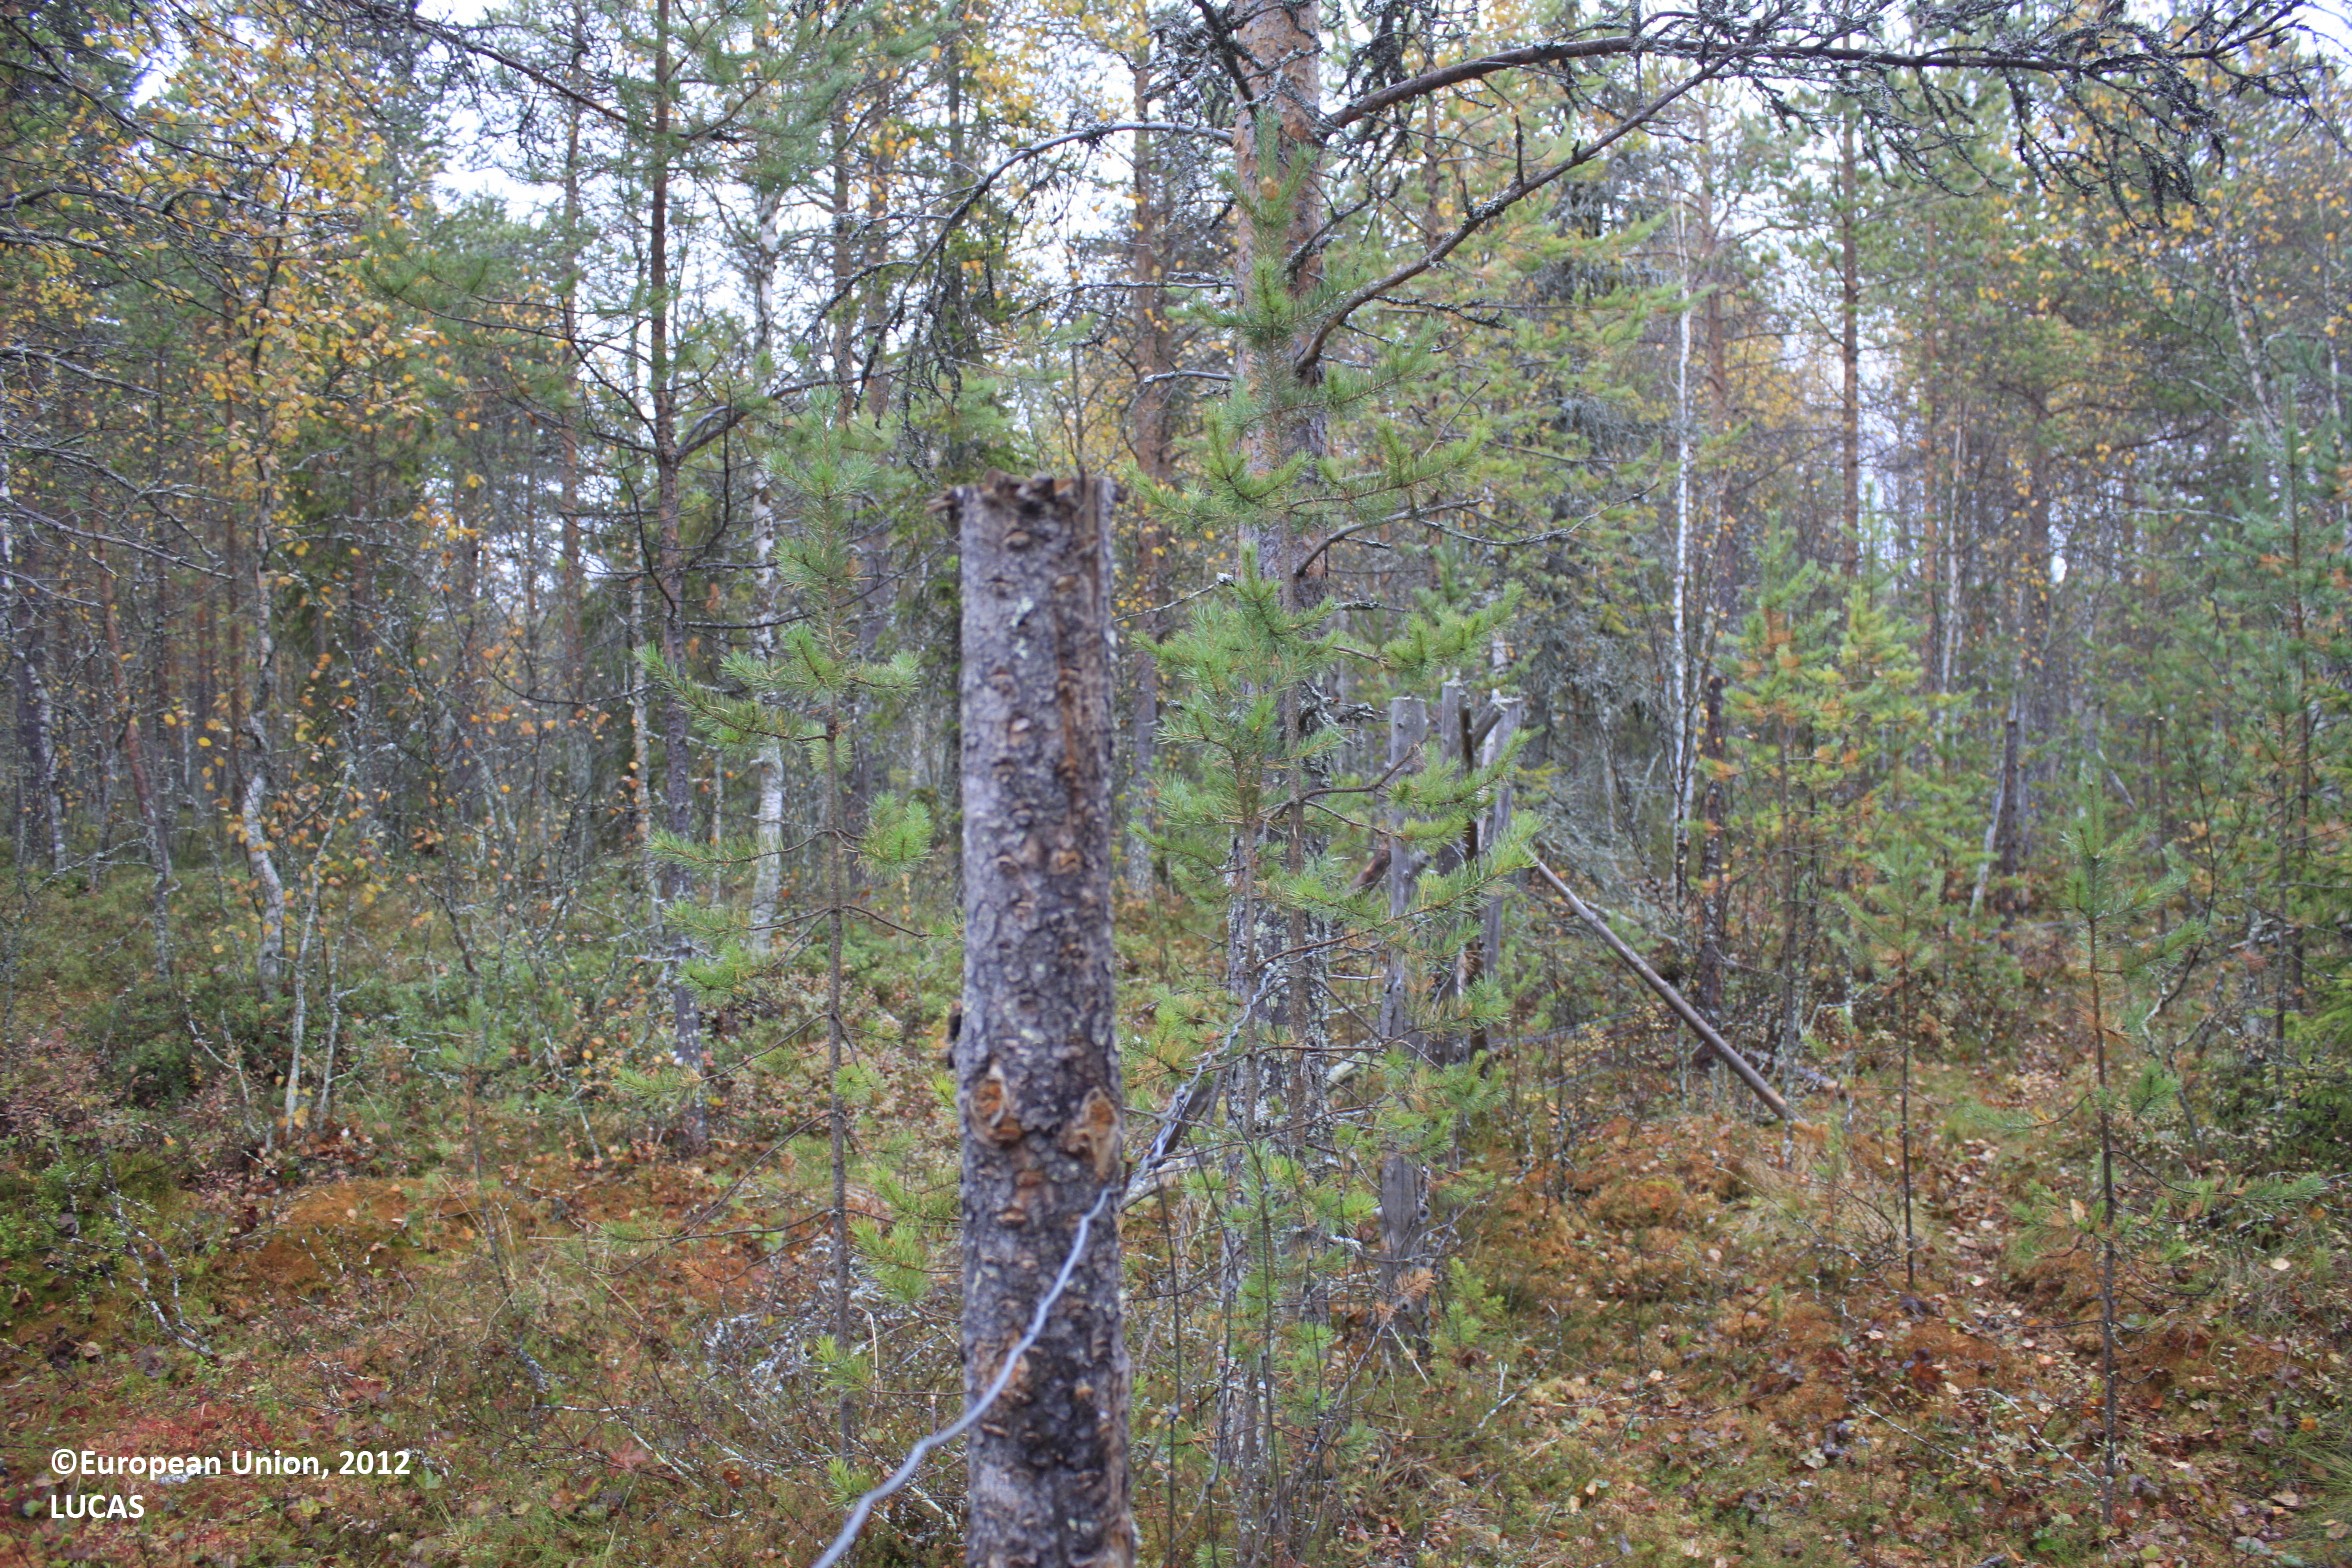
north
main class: Woodland
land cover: Pine dominated mixed woodland
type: mire and swamp forests
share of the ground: 25 - 50 %
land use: Forestry
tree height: > 5 m
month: September
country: FI
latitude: 65.7495
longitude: 27.4264
